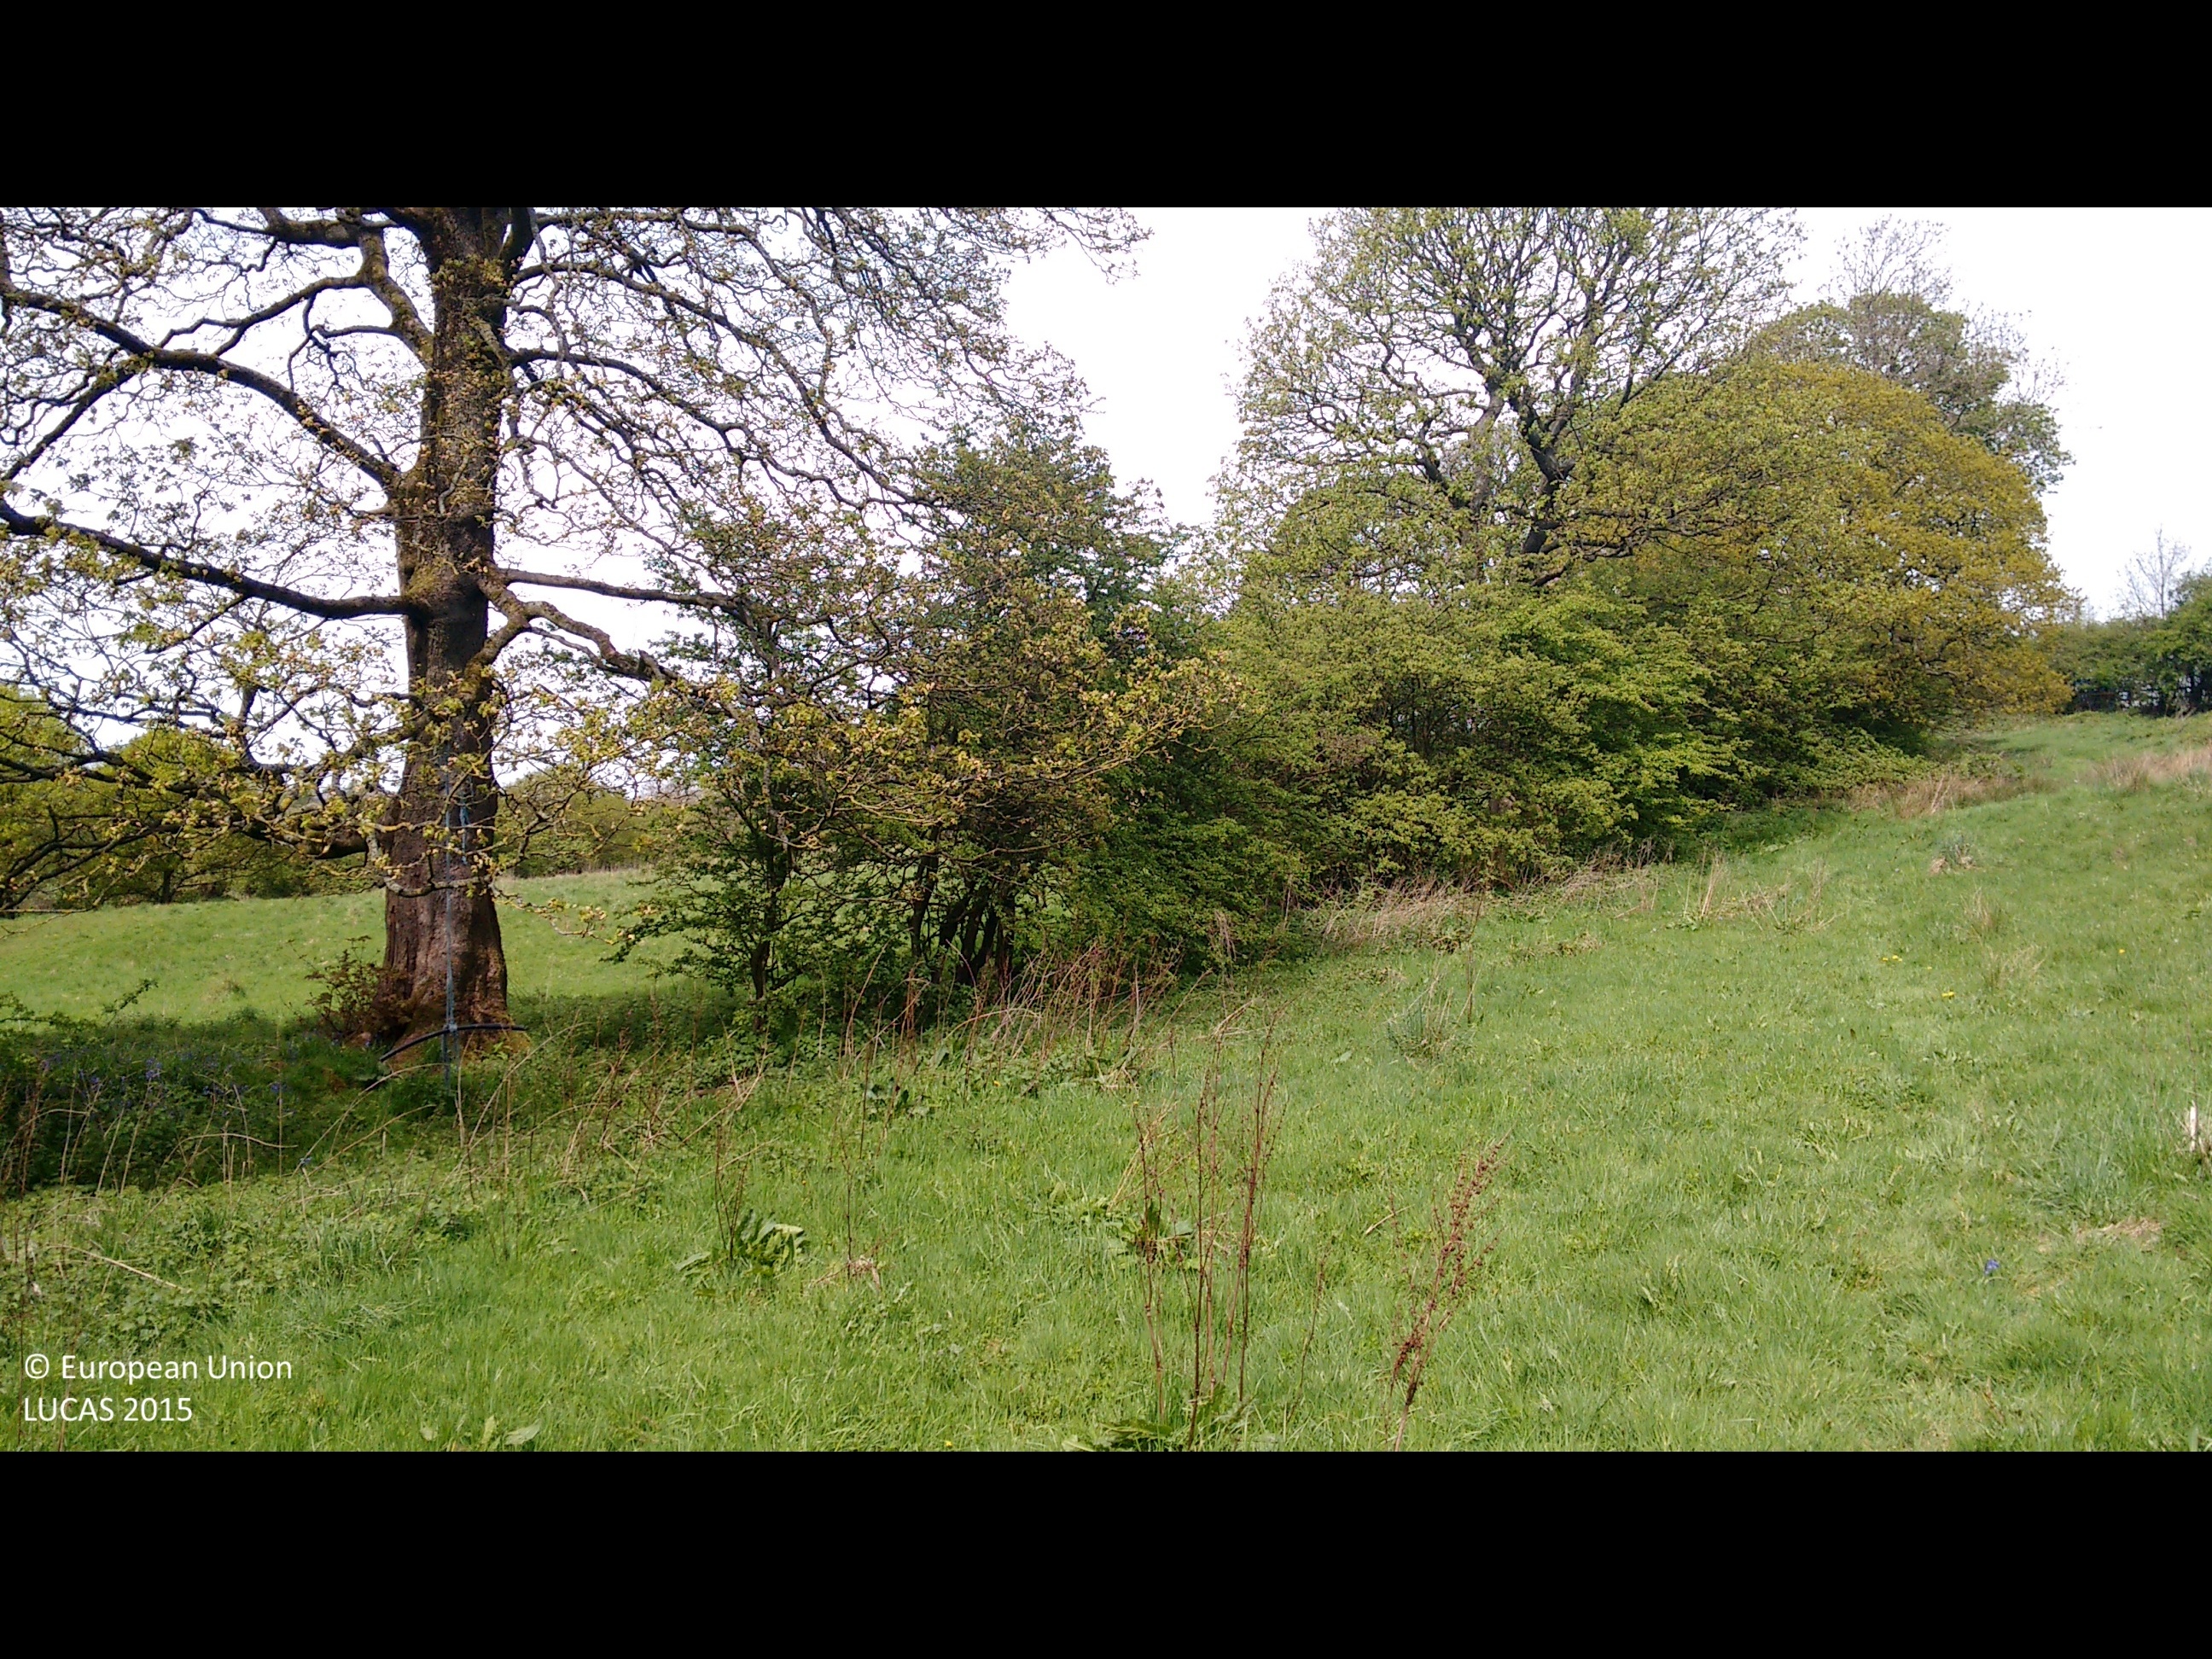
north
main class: Grassland
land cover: Grassland without tree/shrub cover
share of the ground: > 75 %
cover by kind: herbaceous plants 100 %
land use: Agriculture (excluding fallow land and kitchen gardens)
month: May
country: GB
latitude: 53.6500
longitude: -2.6090
